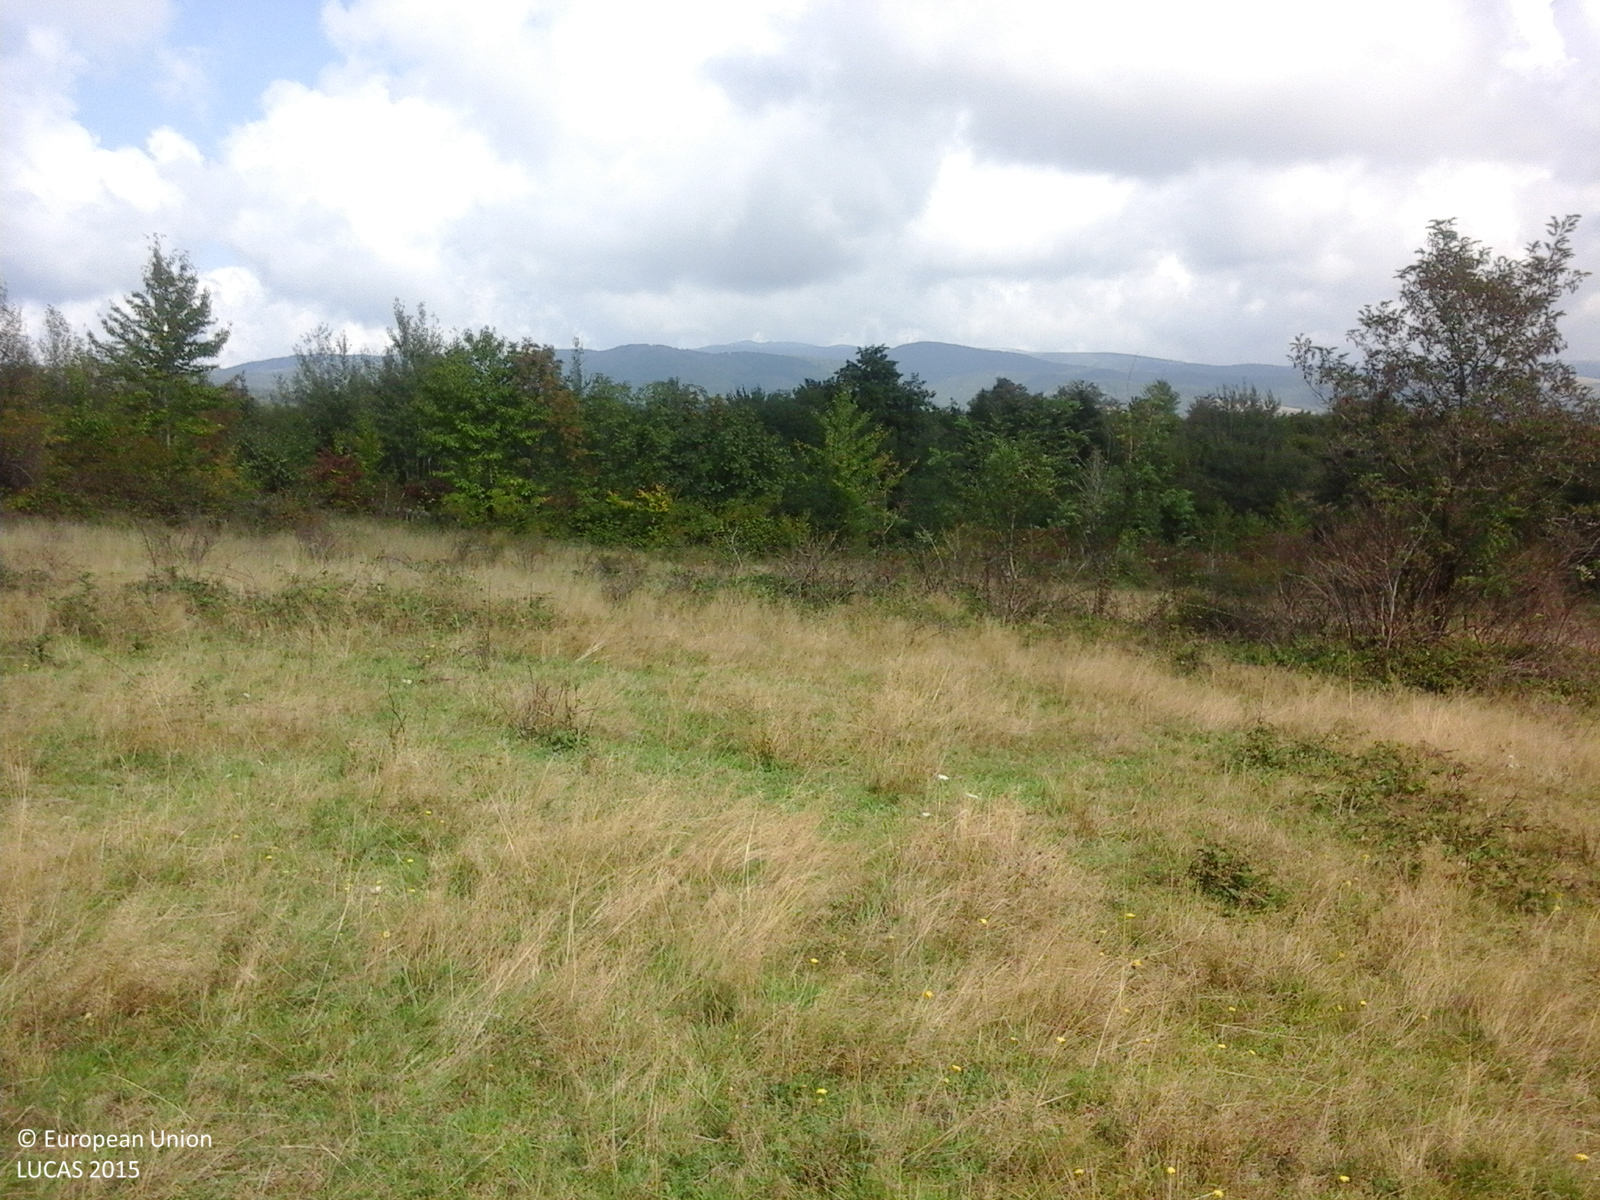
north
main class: Grassland
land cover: Grassland with sparse tree/shrub cover
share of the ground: > 75 %
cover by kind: herbaceous plants 95 %, broadleaved forest trees 5 %
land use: Agriculture (excluding fallow land and kitchen gardens)
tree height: > 5 m
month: September
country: RO
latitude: 45.1502
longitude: 23.4509
